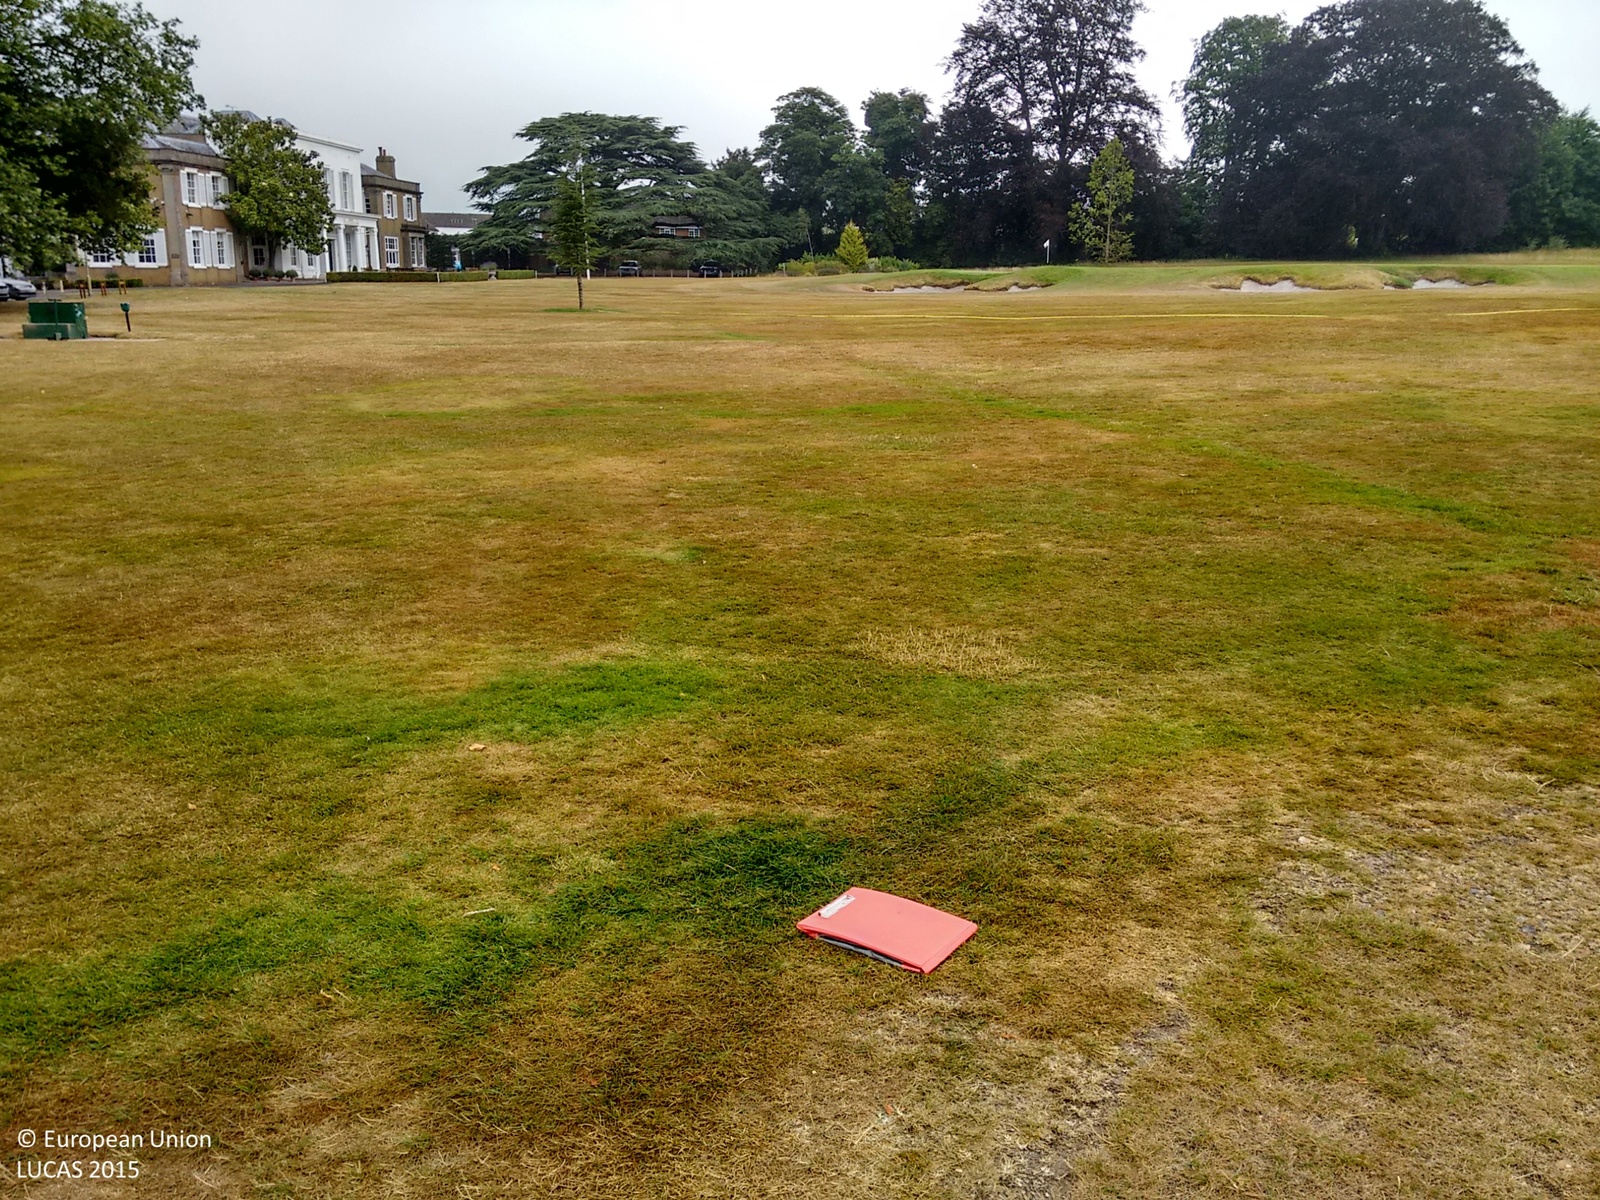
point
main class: Grassland
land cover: Grassland without tree/shrub cover
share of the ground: > 75 %
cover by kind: herbaceous plants 100 %
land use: Sport
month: July
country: GB
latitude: 51.2667
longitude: -0.3994
